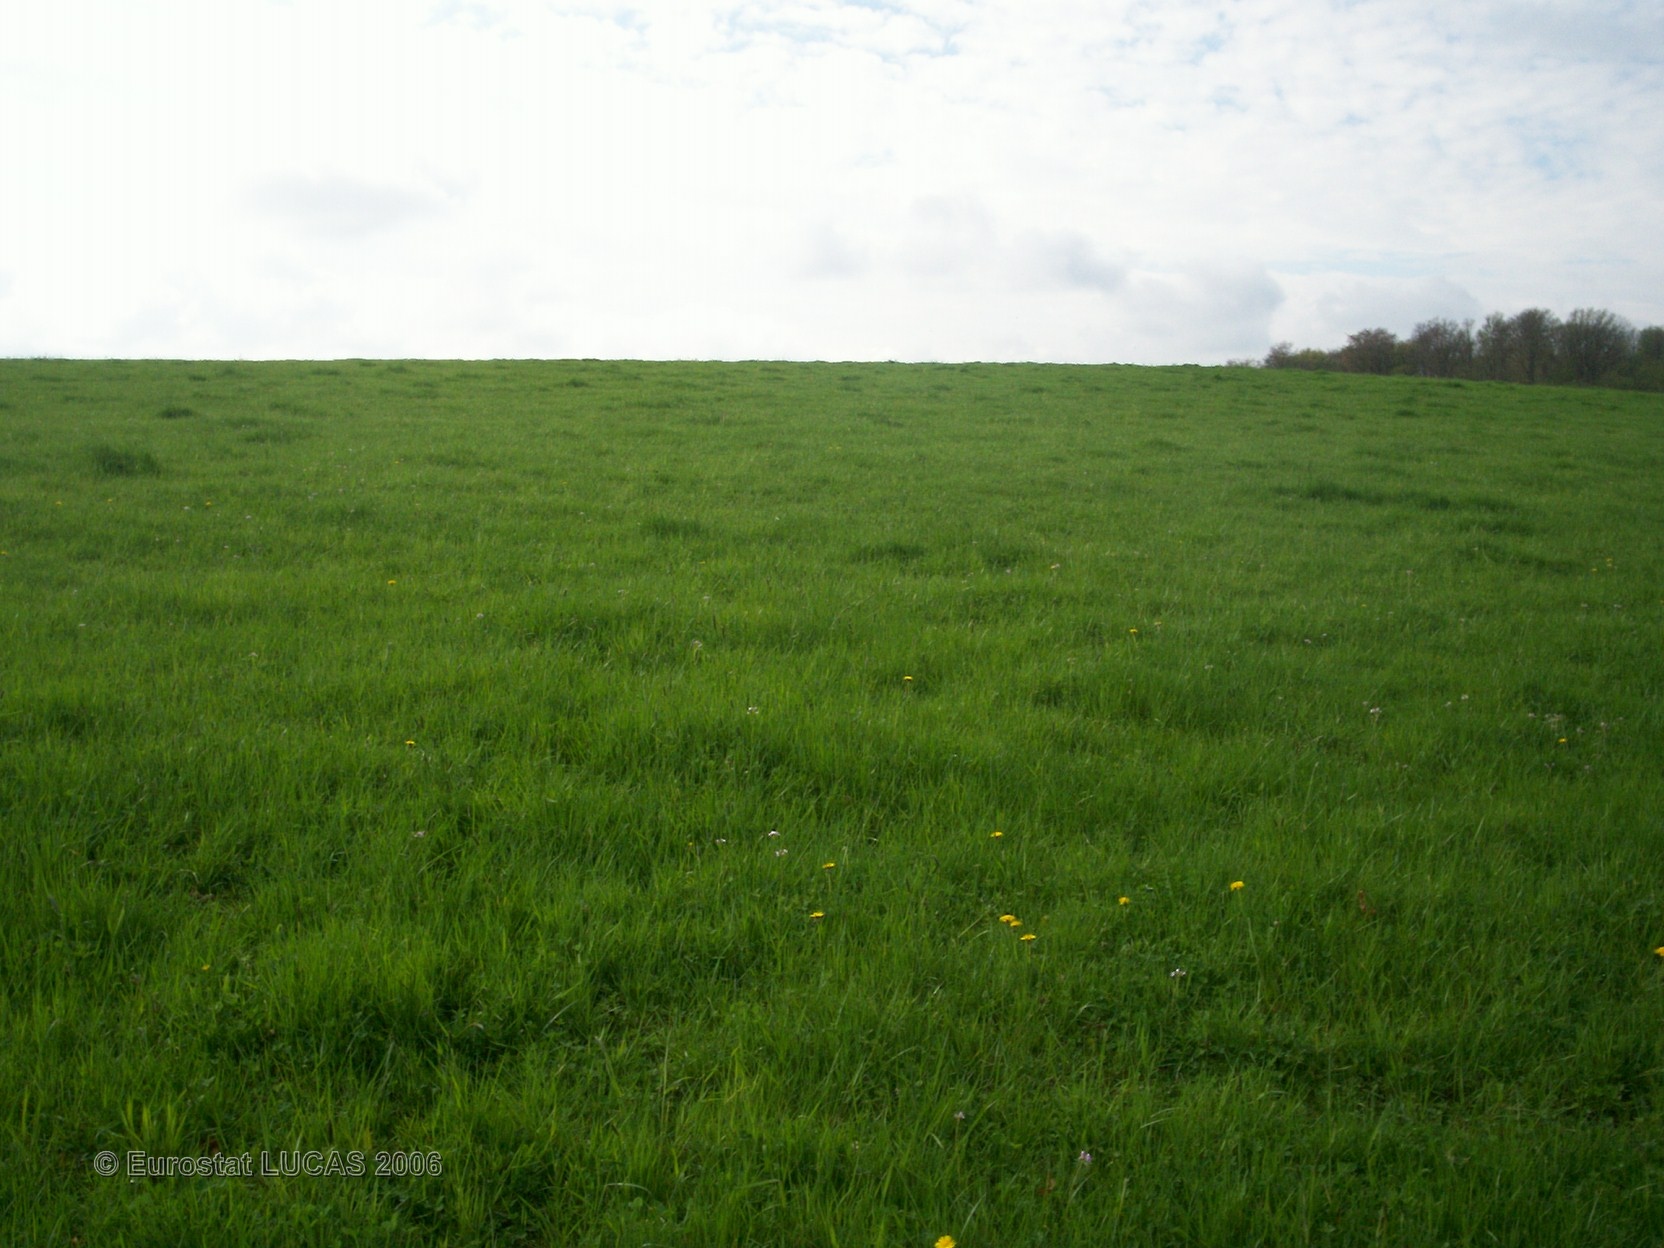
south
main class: Grassland
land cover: Grassland without tree/shrub cover
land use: Agriculture (excluding fallow land and kitchen gardens)
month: April
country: FR
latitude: 48.7878
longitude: 6.7474
